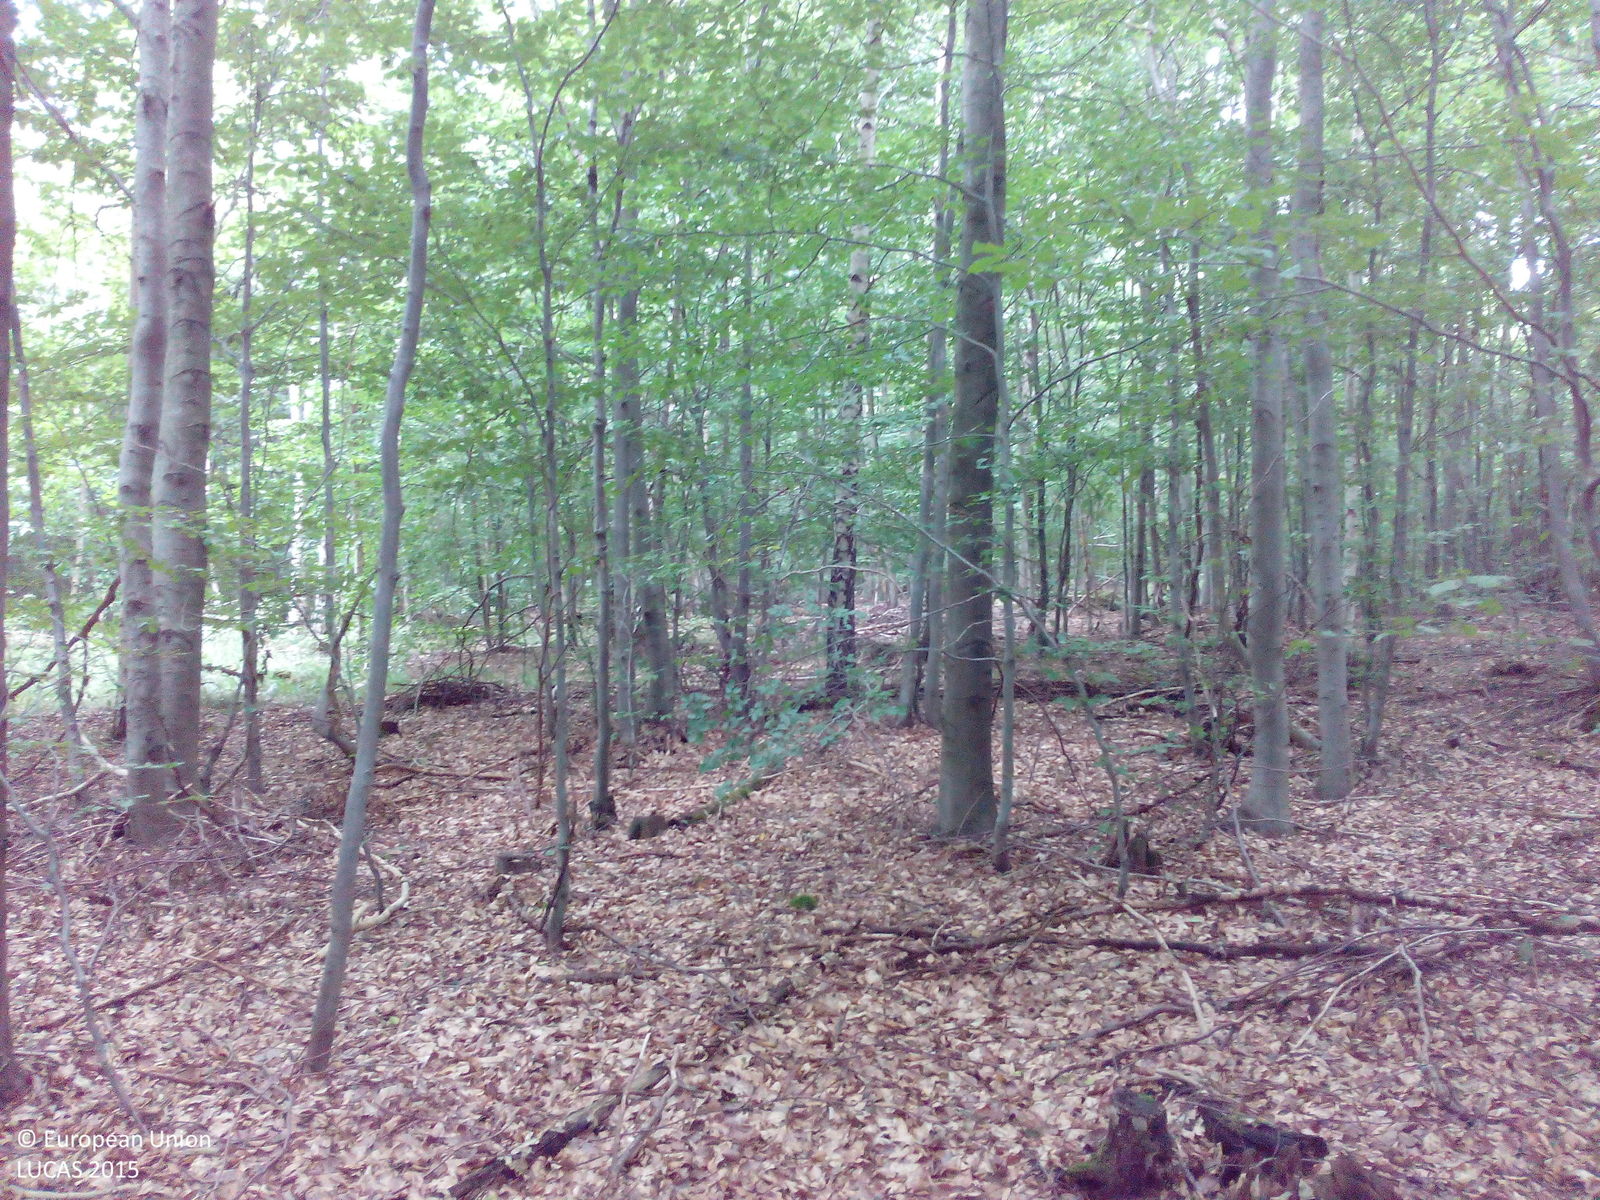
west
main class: Woodland
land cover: Broadleaved woodland
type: beech forest
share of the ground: > 75 %
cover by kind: broadleaved forest trees 100 %
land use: Forestry
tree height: > 5 m
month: August
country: DE
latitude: 51.6891
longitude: 11.1135
